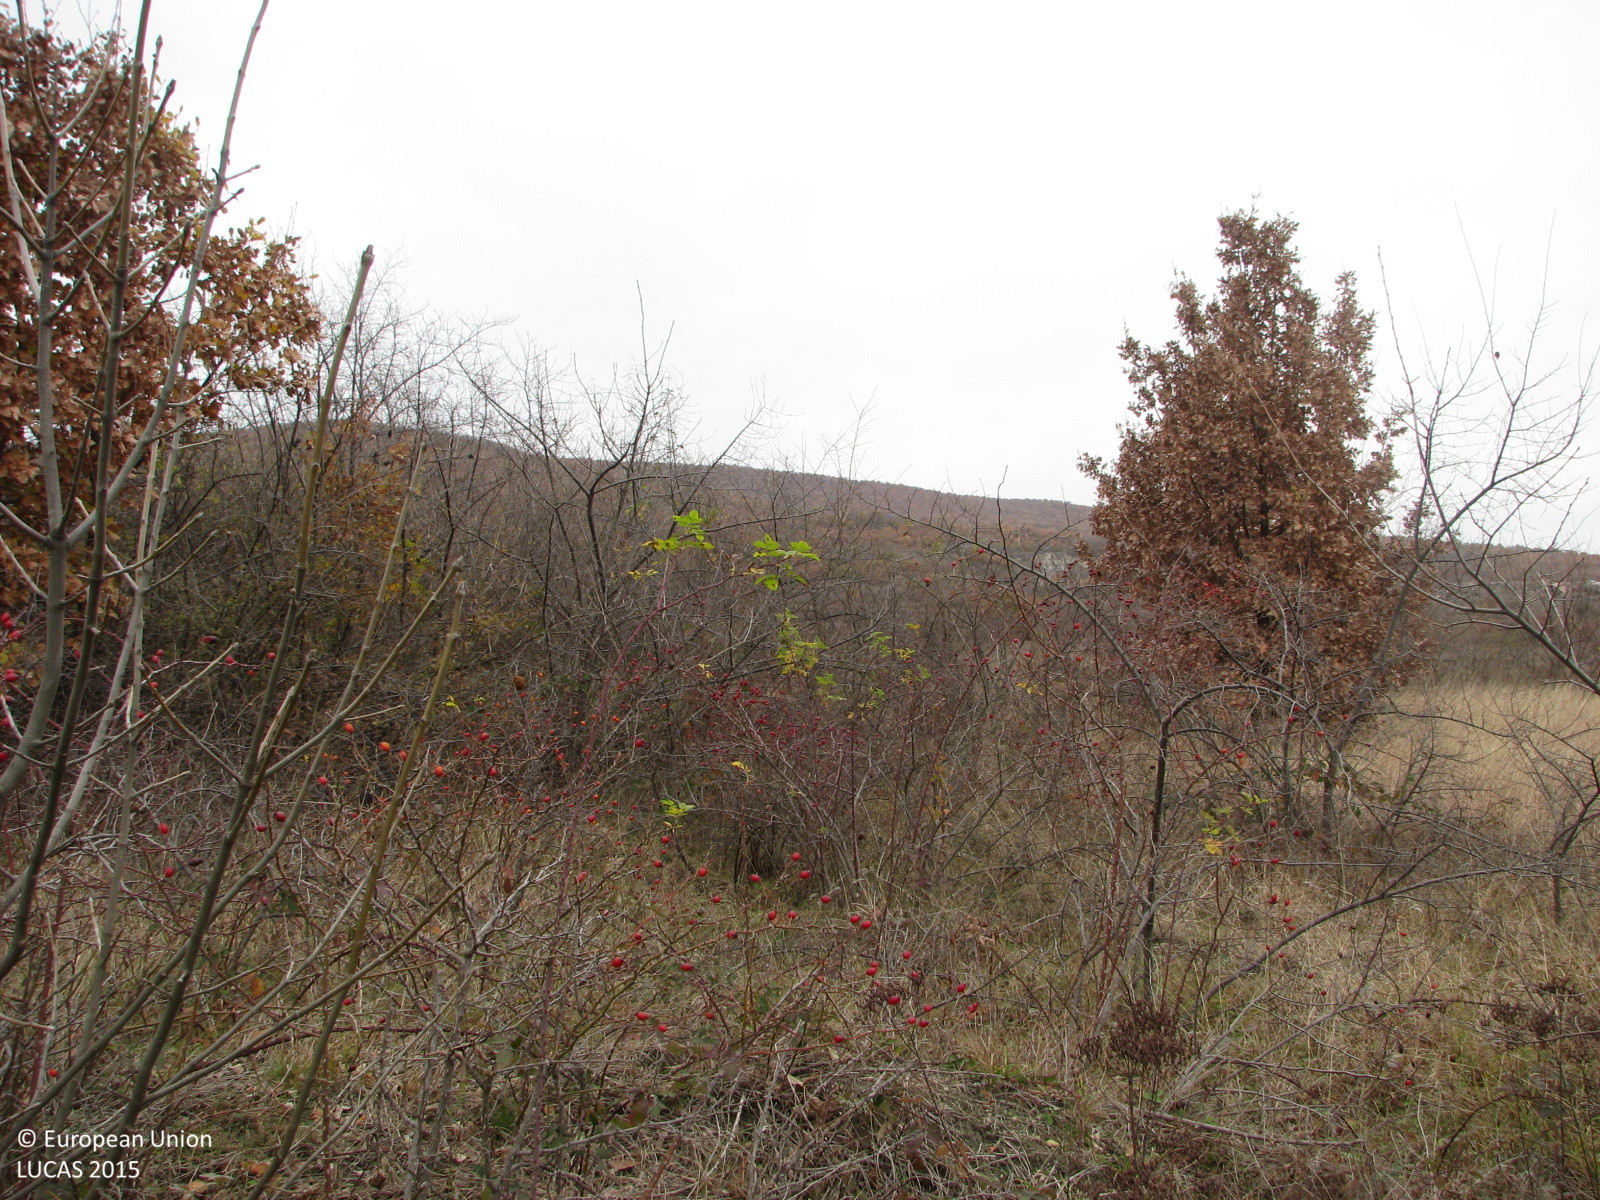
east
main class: Shrubland
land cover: Shrubland with sparse tree cover
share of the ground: 50 - 75 %
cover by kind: shrubs 65 %, herbaceous plants 30 %, broadleaved forest trees 5 %
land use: Semi-natural and natural areas not in use
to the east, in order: Shrubland with sparse tree cover; Grassland without tree/shrub cover; Shrubland with sparse tree cover; Tracks; Shrubland with sparse tree cover
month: December
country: BG
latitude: 42.2882
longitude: 24.0732
